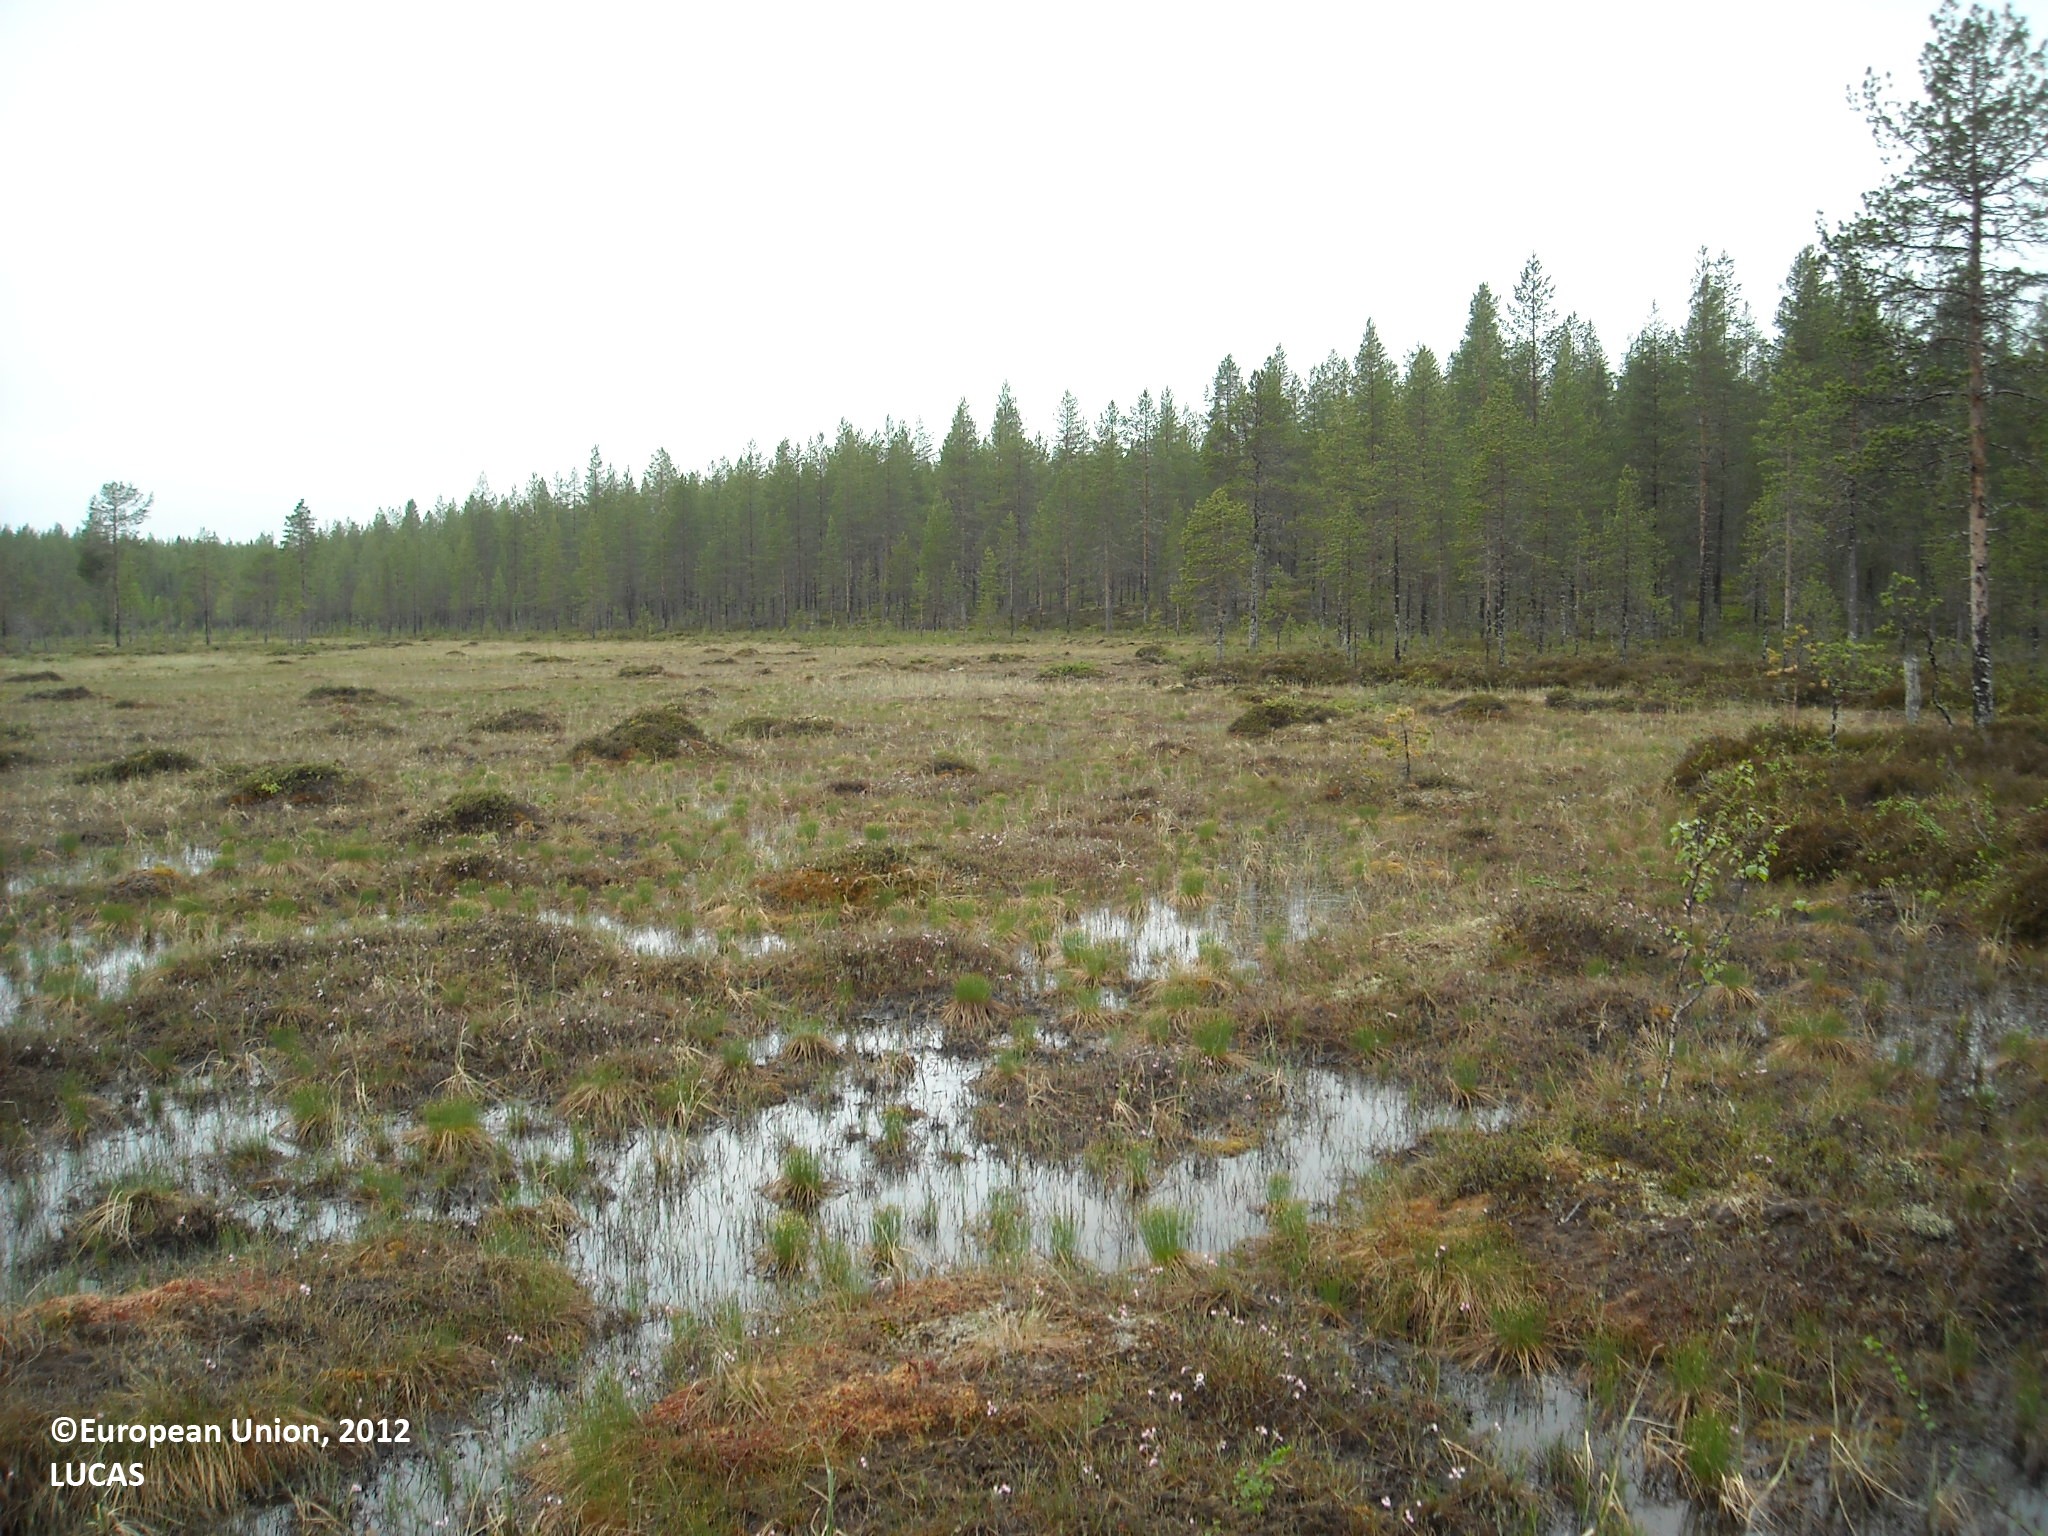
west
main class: Woodland
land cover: Pine dominated coniferous woodland
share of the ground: 25 - 50 %
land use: Semi-natural and natural areas not in use
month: June
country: FI
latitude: 65.5688
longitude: 27.8865
